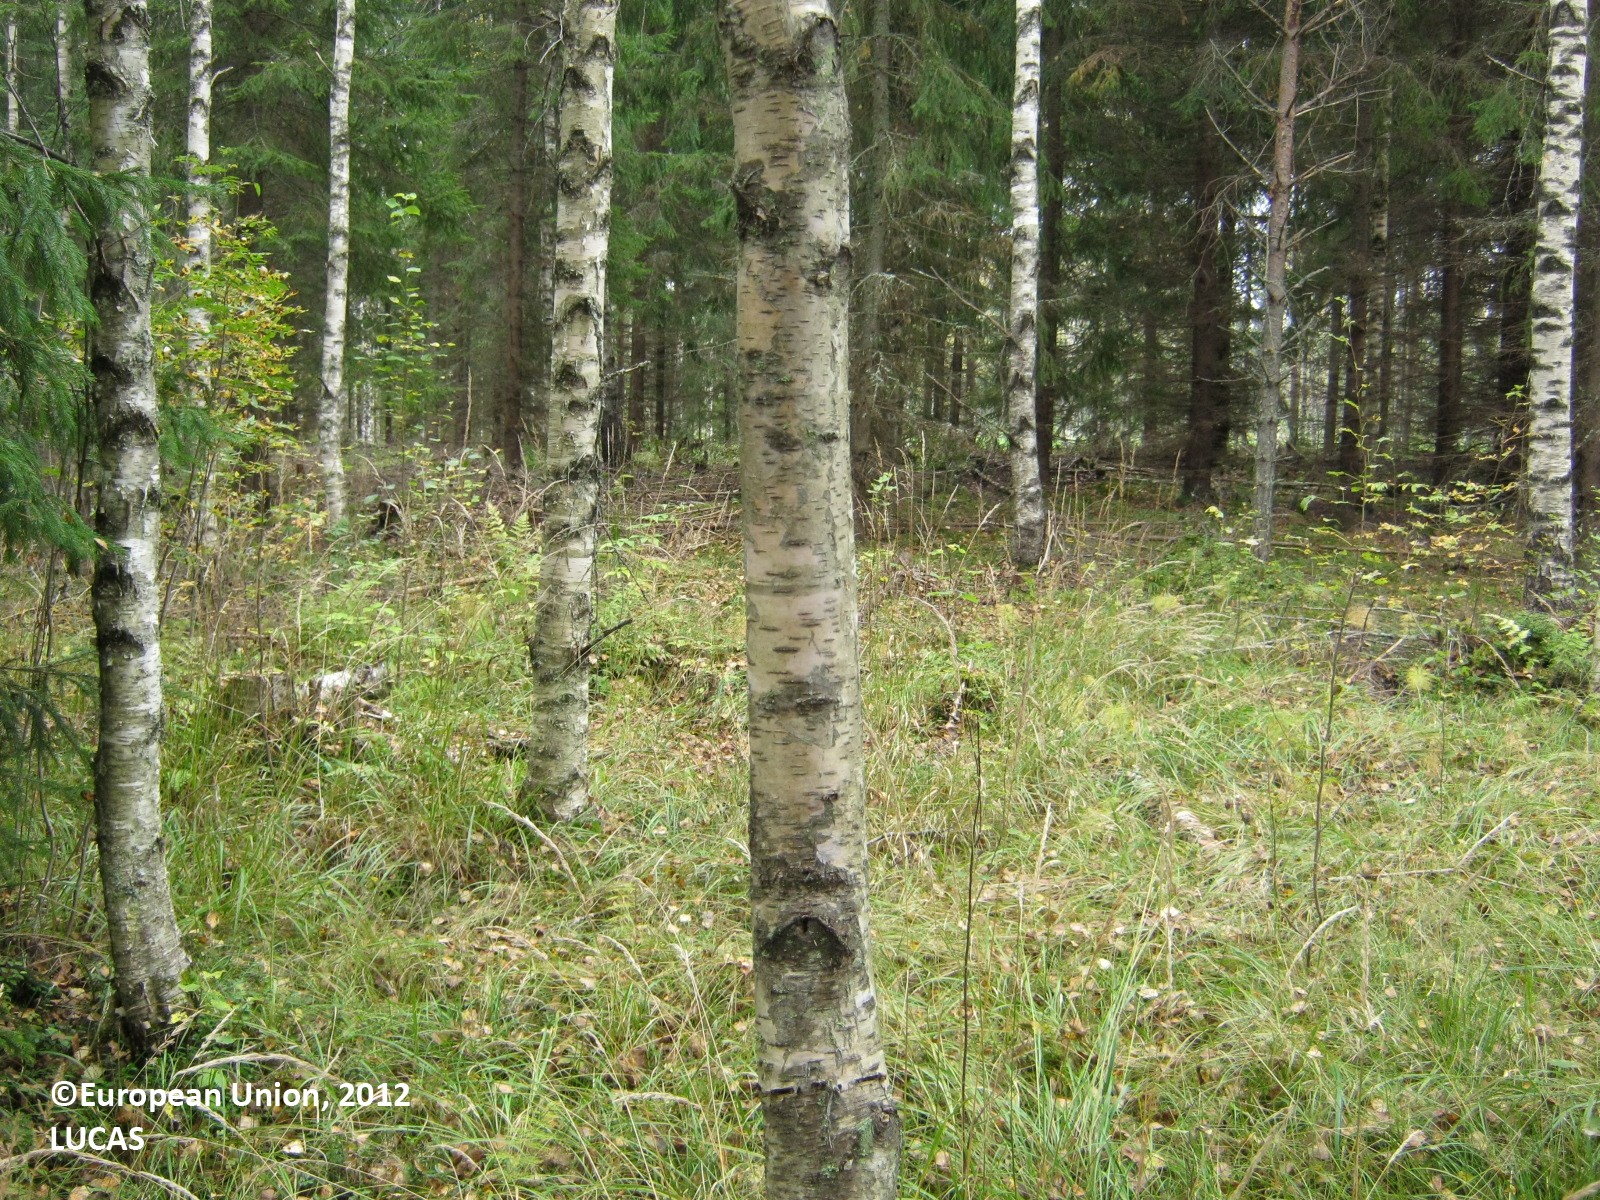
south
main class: Woodland
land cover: Other mixed woodland
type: boreal forest
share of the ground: > 75 %
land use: Forestry
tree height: > 5 m
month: September
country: FI
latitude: 61.0047
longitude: 28.0468
